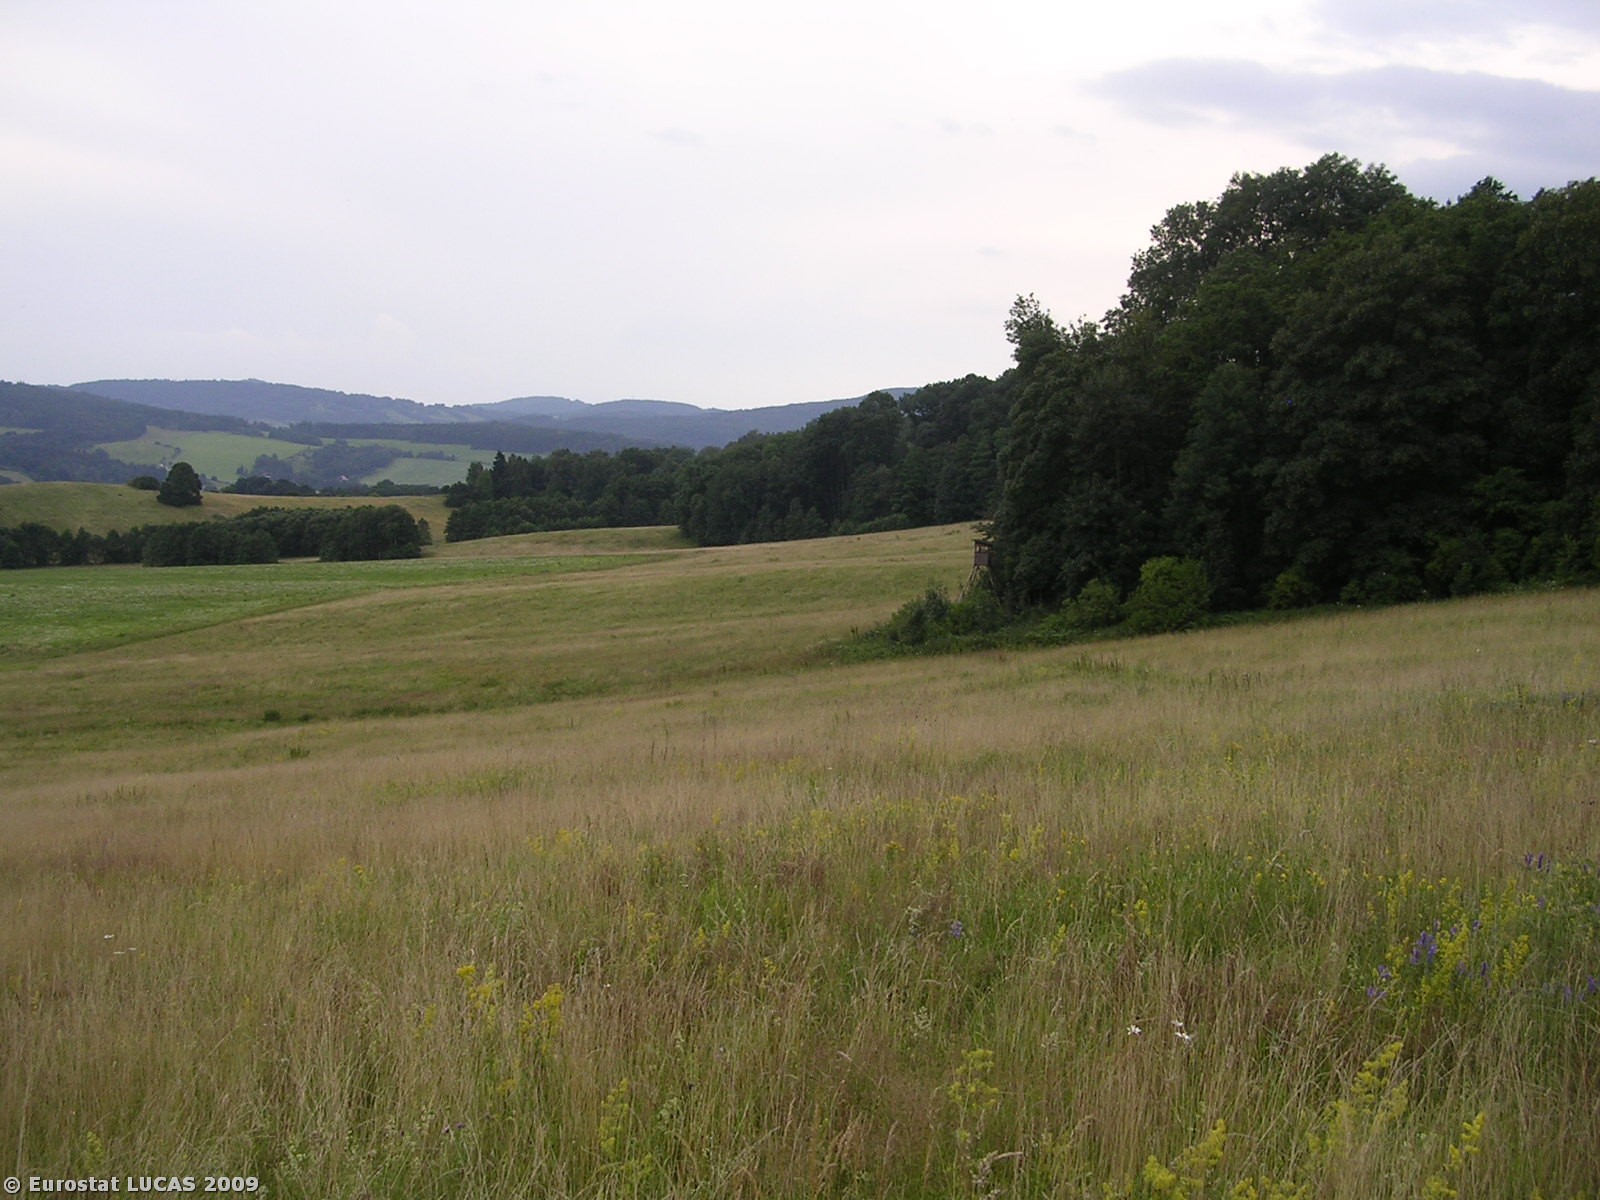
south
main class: Grassland
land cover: Grassland without tree/shrub cover
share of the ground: > 75 %
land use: Agriculture (excluding fallow land and kitchen gardens)
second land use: Nature reserves
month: July
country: CZ
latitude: 50.7684
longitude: 14.3261
